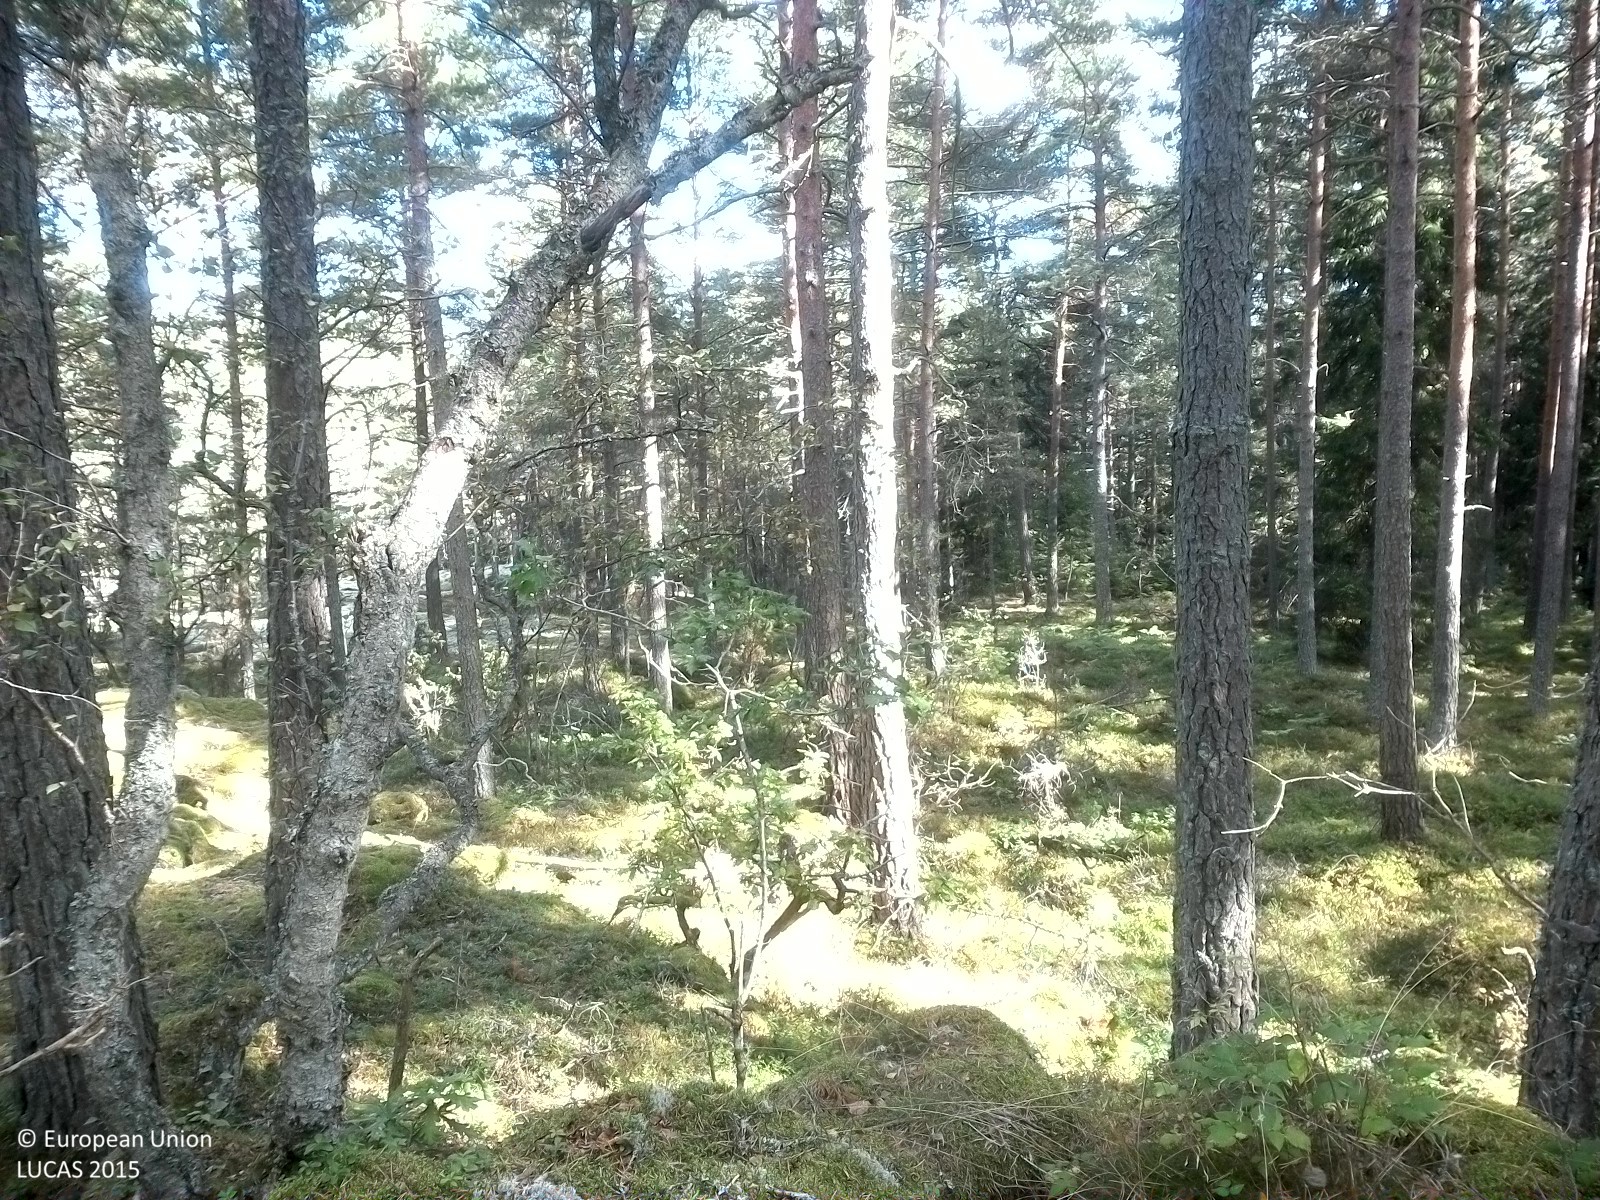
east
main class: Woodland
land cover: Pine dominated coniferous woodland
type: boreal forest
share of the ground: 25 - 50 %
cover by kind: herbaceous plants 55 %, coniferous forest trees 25 %, lichens and mosses 15 %, broadleaved forest trees 5 %
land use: Forestry
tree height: > 5 m
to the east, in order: Pine dominated coniferous woodland; Pine dominated mixed woodland; Spruce dominated coniferous woodland; Ditches and canals; Pine dominated mixed woodland
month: September
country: SE
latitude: 58.5232
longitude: 16.2971
